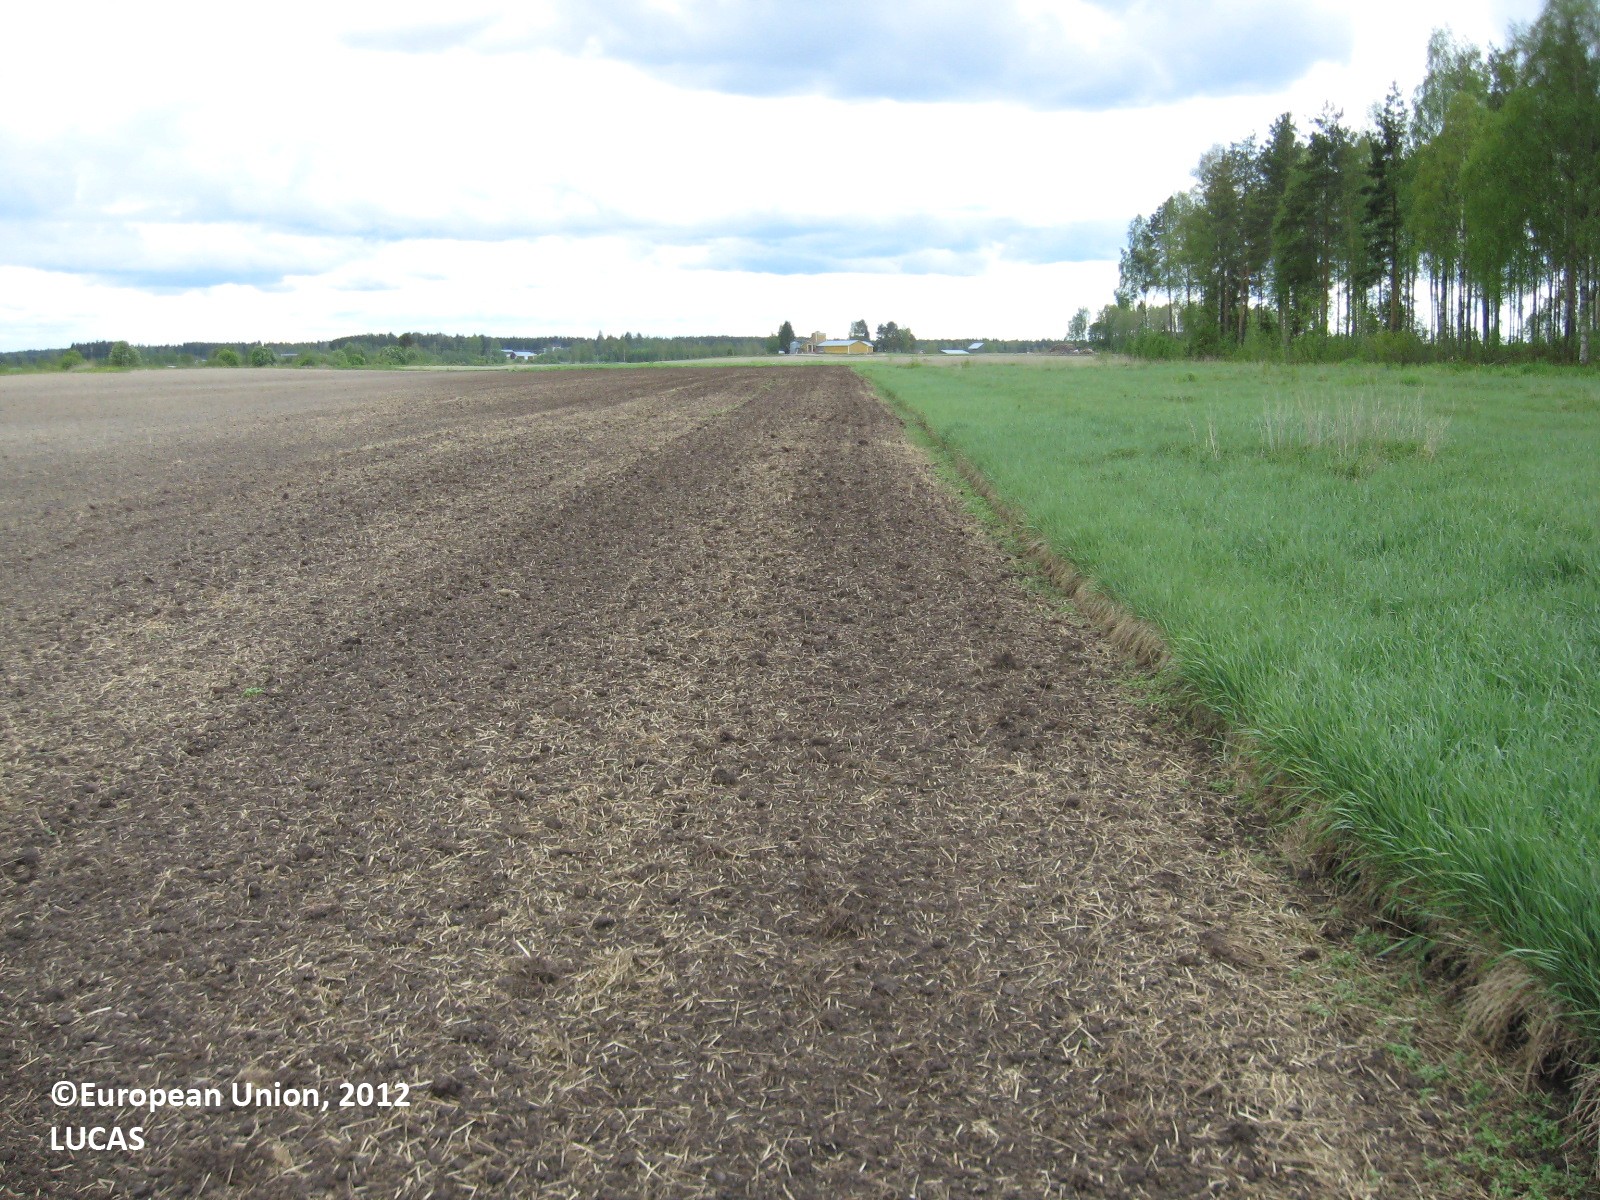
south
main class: Cropland
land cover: Other cereals
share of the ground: < 10 %
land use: Agriculture (excluding fallow land and kitchen gardens)
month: May
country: FI
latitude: 61.8311
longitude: 22.3060
